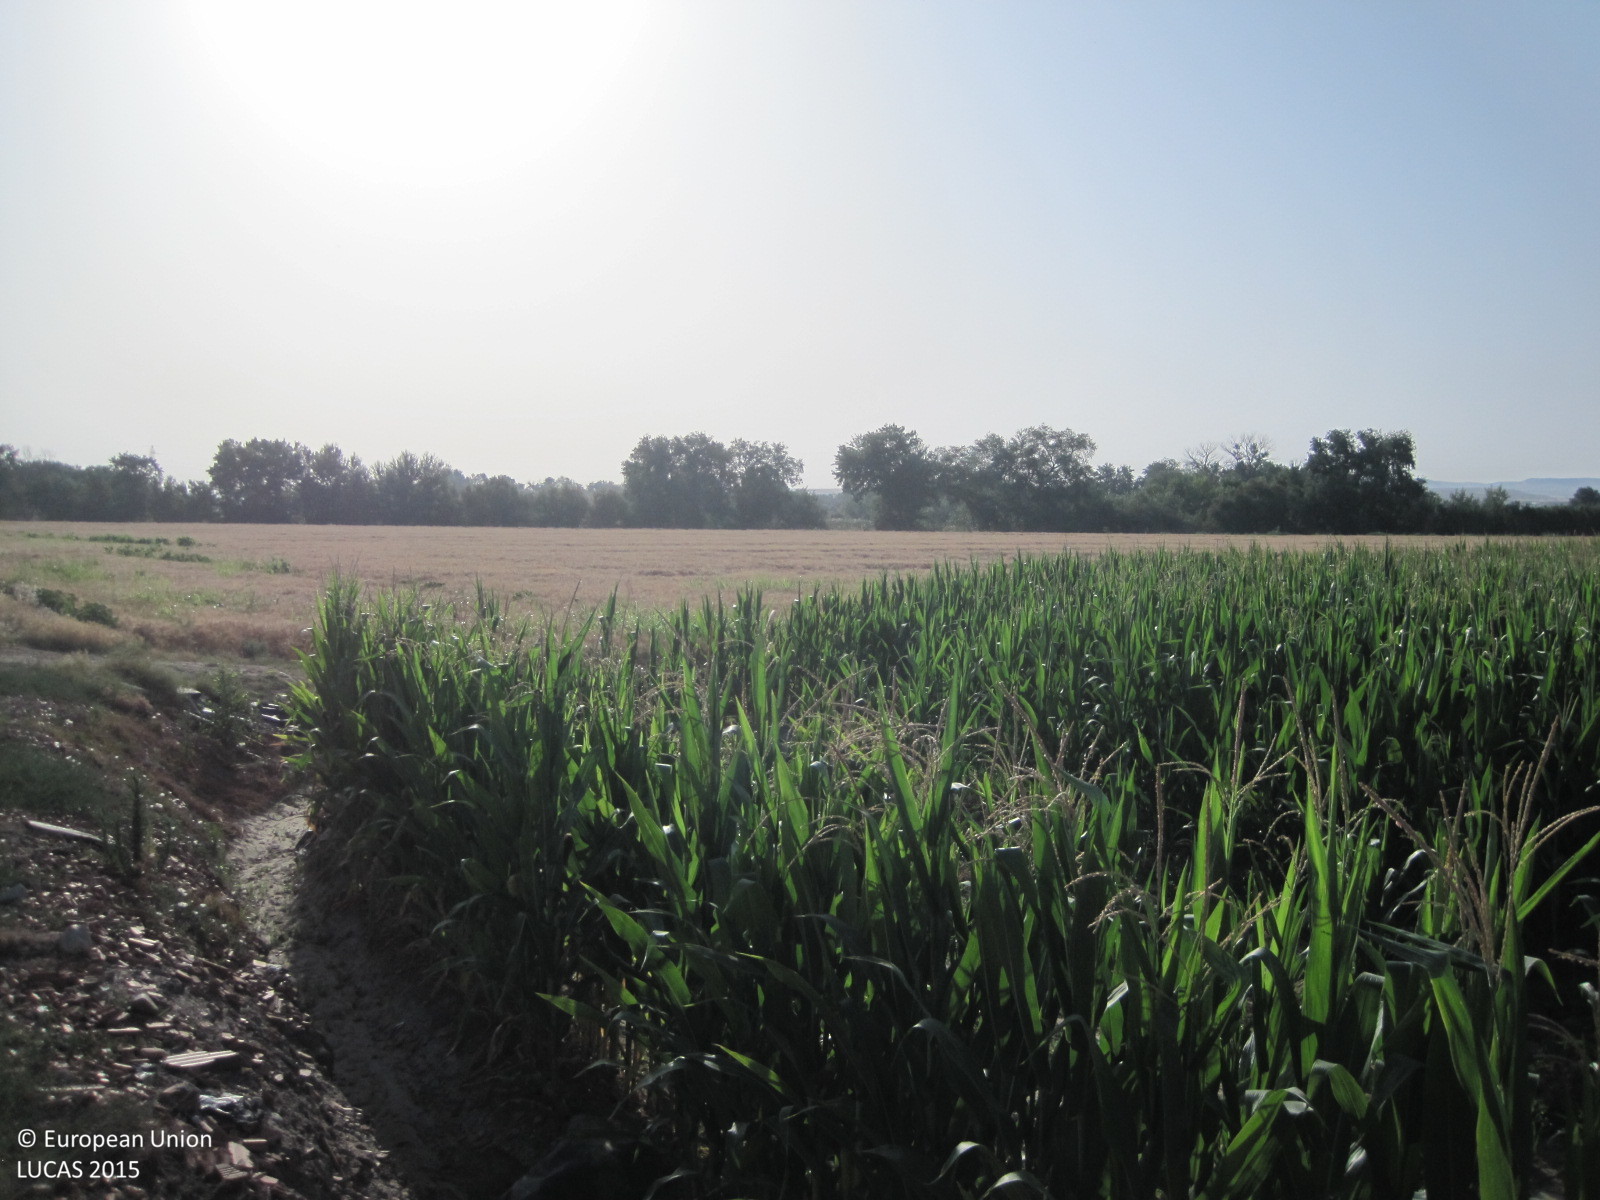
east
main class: Cropland
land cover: Maize
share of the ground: > 75 %
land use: Agriculture (excluding fallow land and kitchen gardens)
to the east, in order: Maize; Grass margins; Common wheat; Grass margins; Common wheat; Shrubland with sparse tree cover
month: July
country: ES
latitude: 39.9698
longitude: -3.7661
